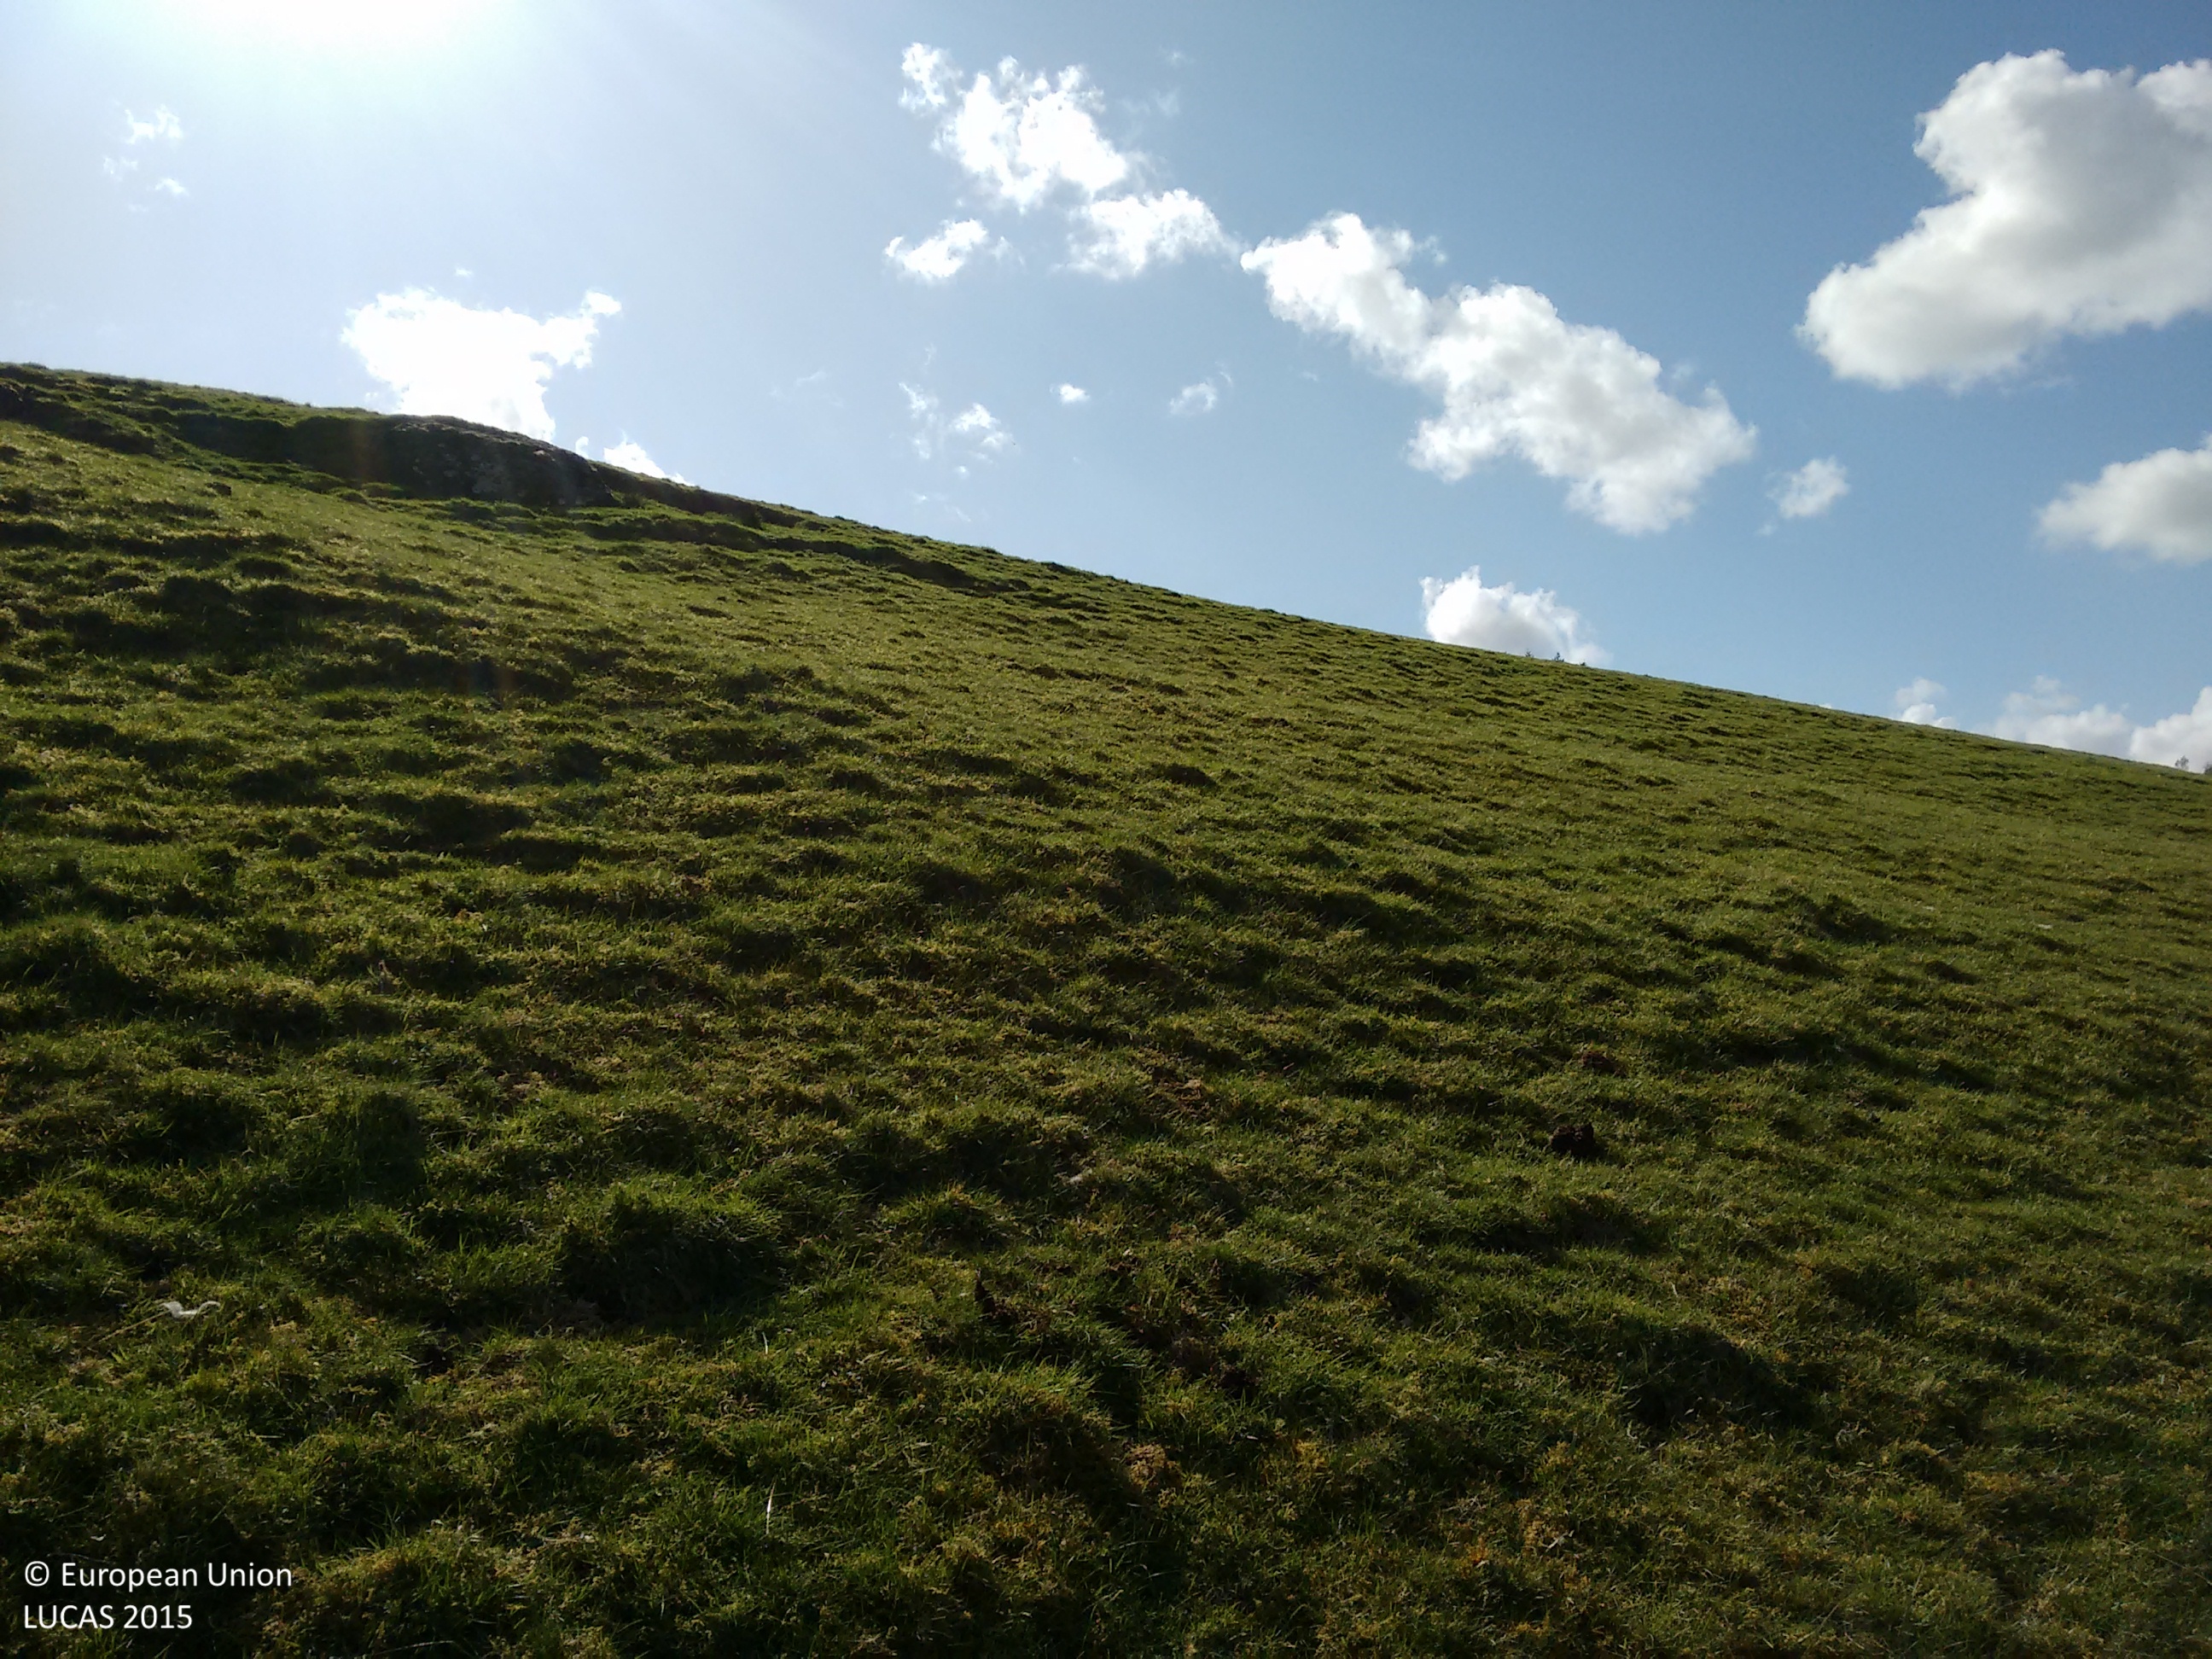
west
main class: Grassland
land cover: Grassland without tree/shrub cover
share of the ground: > 75 %
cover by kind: herbaceous plants 100 %
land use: Agriculture (excluding fallow land and kitchen gardens)
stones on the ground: < 10 %
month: May
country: GB
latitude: 56.1557
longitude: -3.9144
